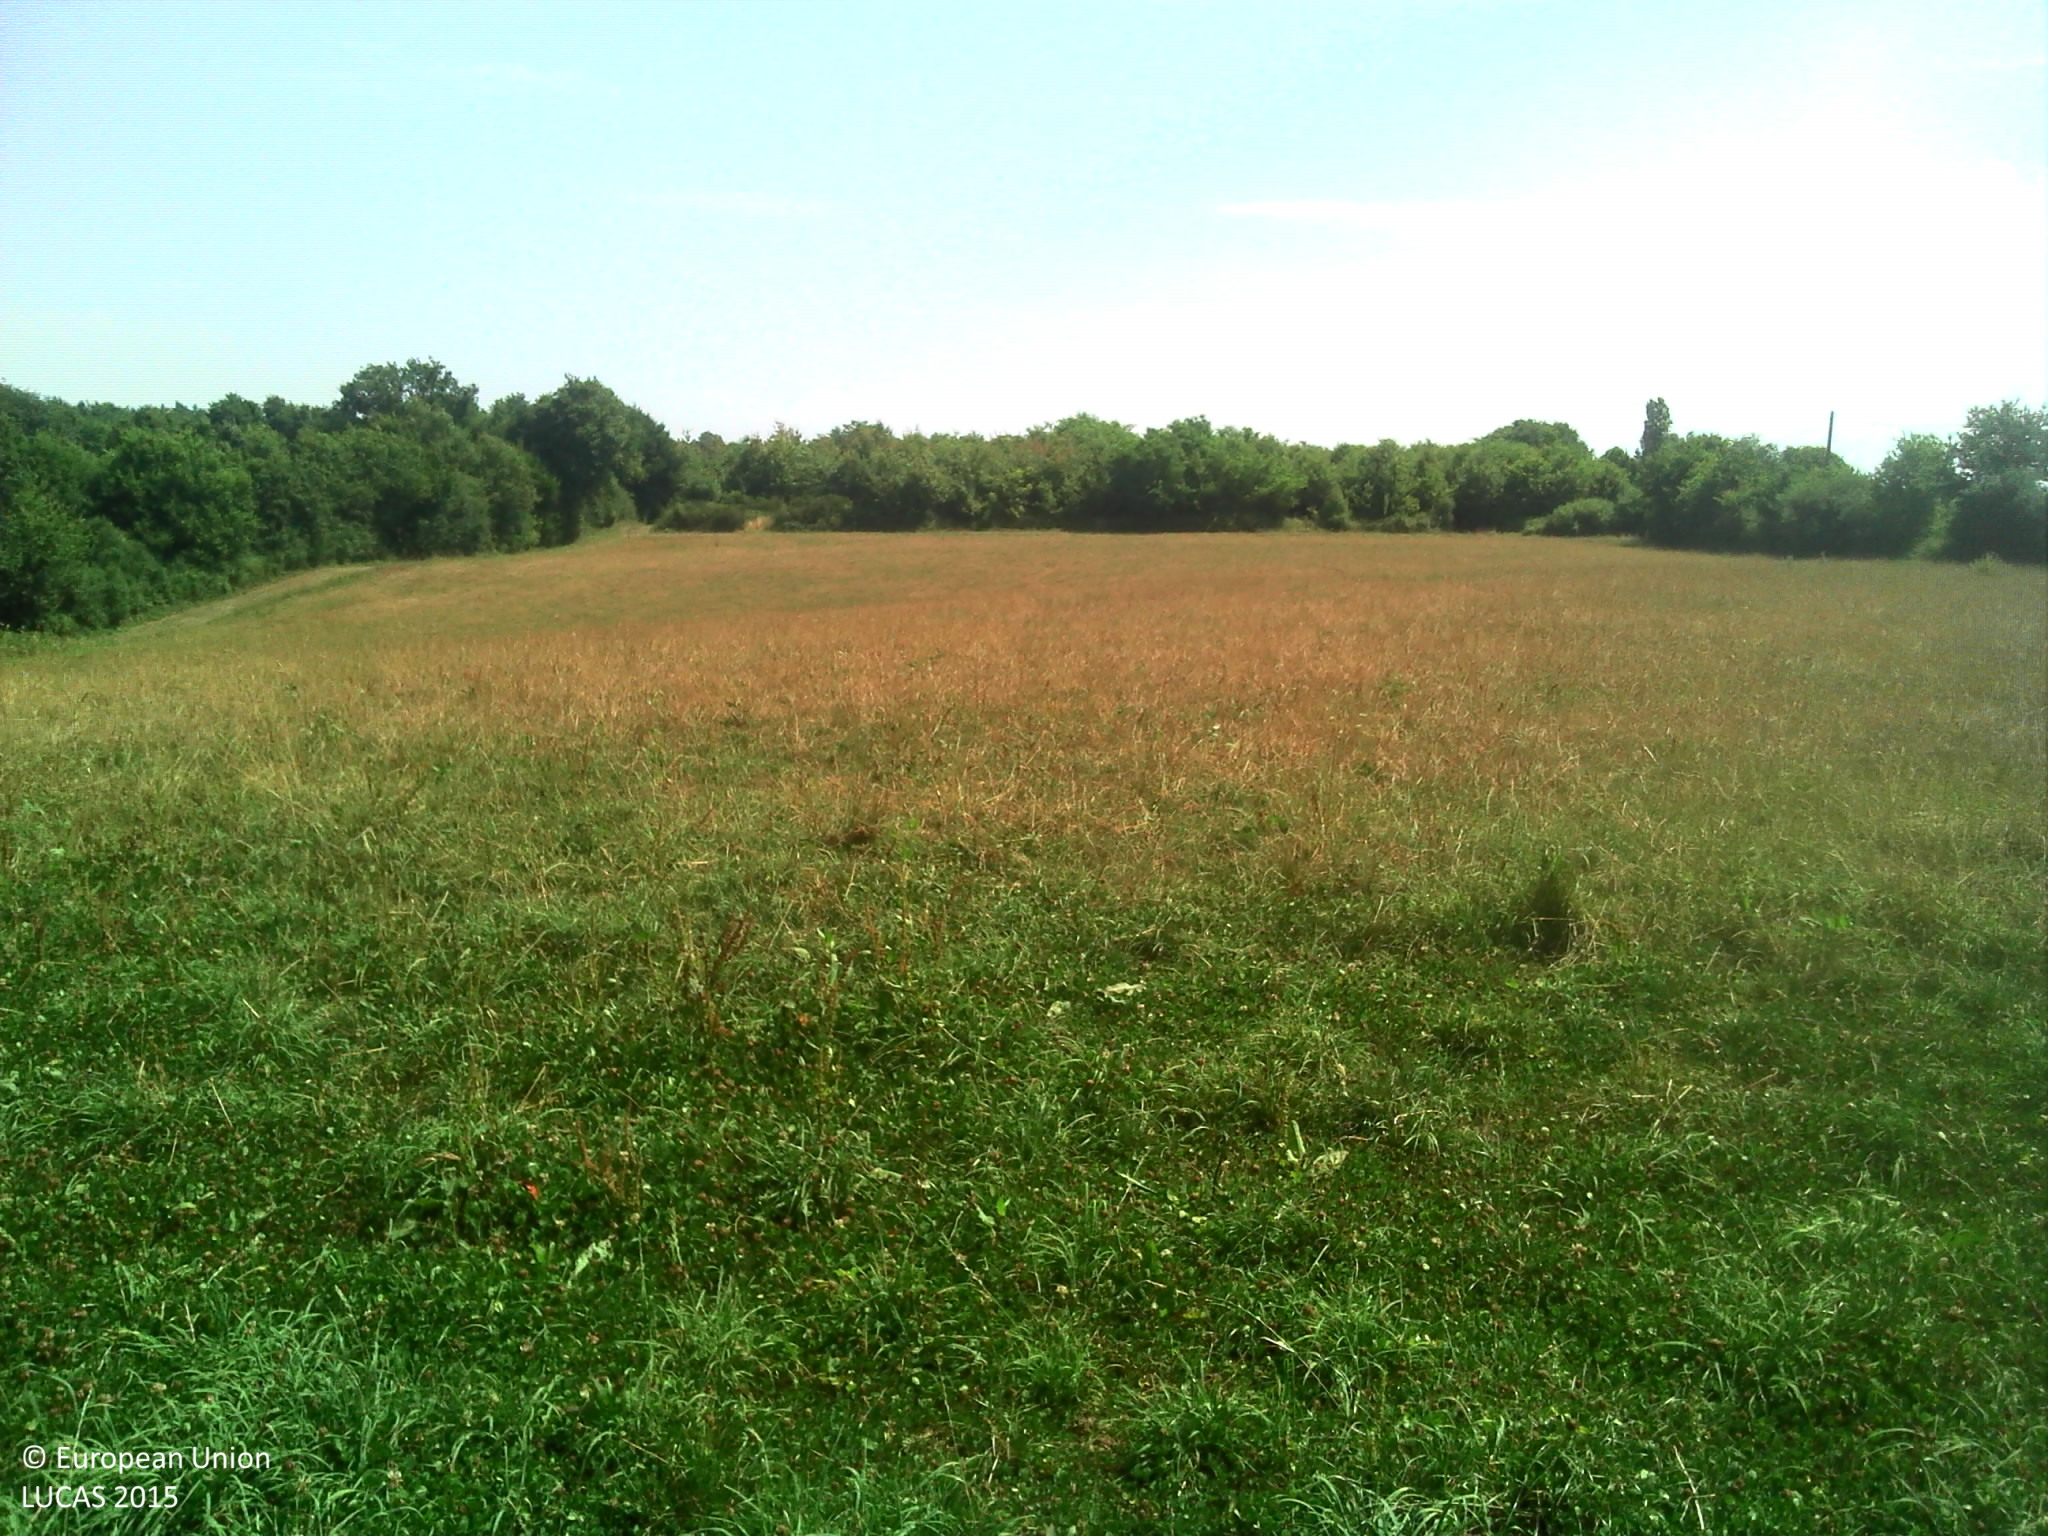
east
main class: Grassland
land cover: Grassland without tree/shrub cover
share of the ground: > 75 %
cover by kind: herbaceous plants 100 %
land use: Agriculture (excluding fallow land and kitchen gardens)
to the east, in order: Abandoned hedges; Grassland without tree/shrub cover; Fences; Grassland without tree/shrub cover; Fences; Abandoned hedges; Electric lines; Ditches and canals; Grass margins; Paved roads, cycling and walking lanes; Grass margins; Electric lines; Abandoned hedges; Grassland without tree/shrub cover; Broadleaved woodland
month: July
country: FR
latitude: 46.5945
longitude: -1.5648
